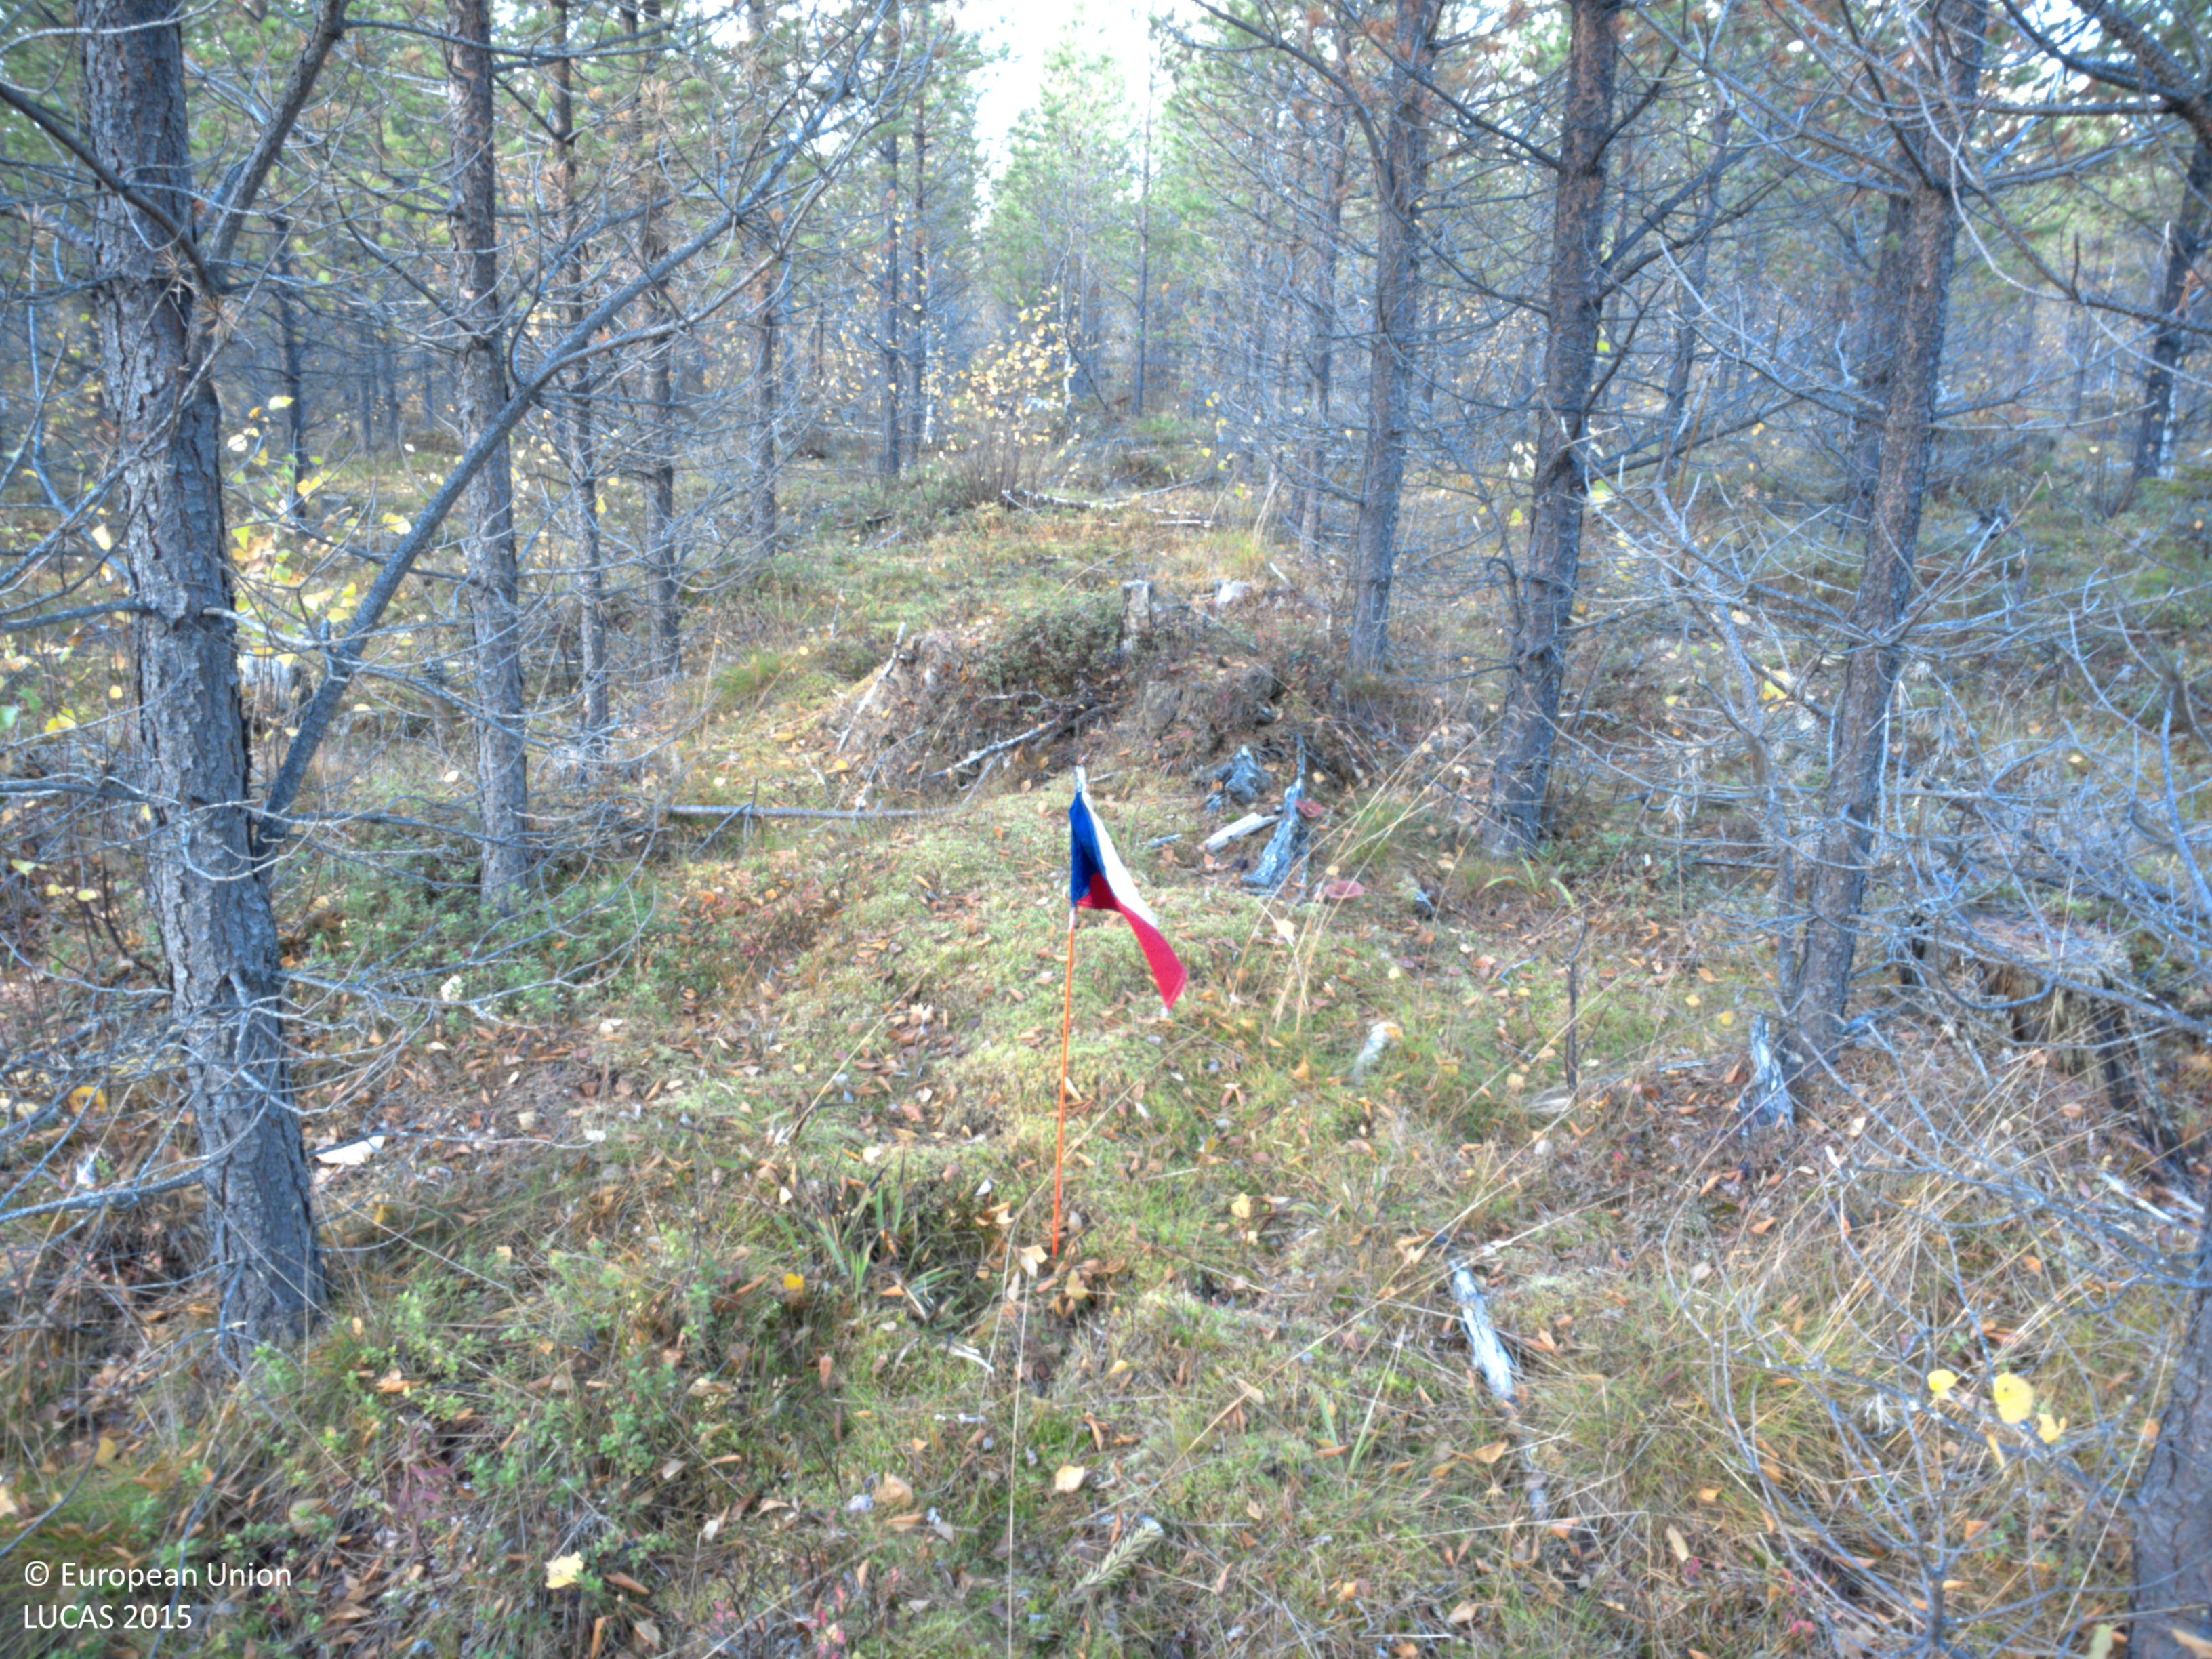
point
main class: Woodland
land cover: Pine dominated coniferous woodland
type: boreal forest
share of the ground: > 75 %
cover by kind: coniferous forest trees 75 %, shrubs 10 %, broadleaved forest trees 5 %, herbaceous plants 5 %, lichens and mosses 5 %
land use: Forestry
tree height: < 5 m
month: October
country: SE
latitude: 64.8893
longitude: 18.3070
